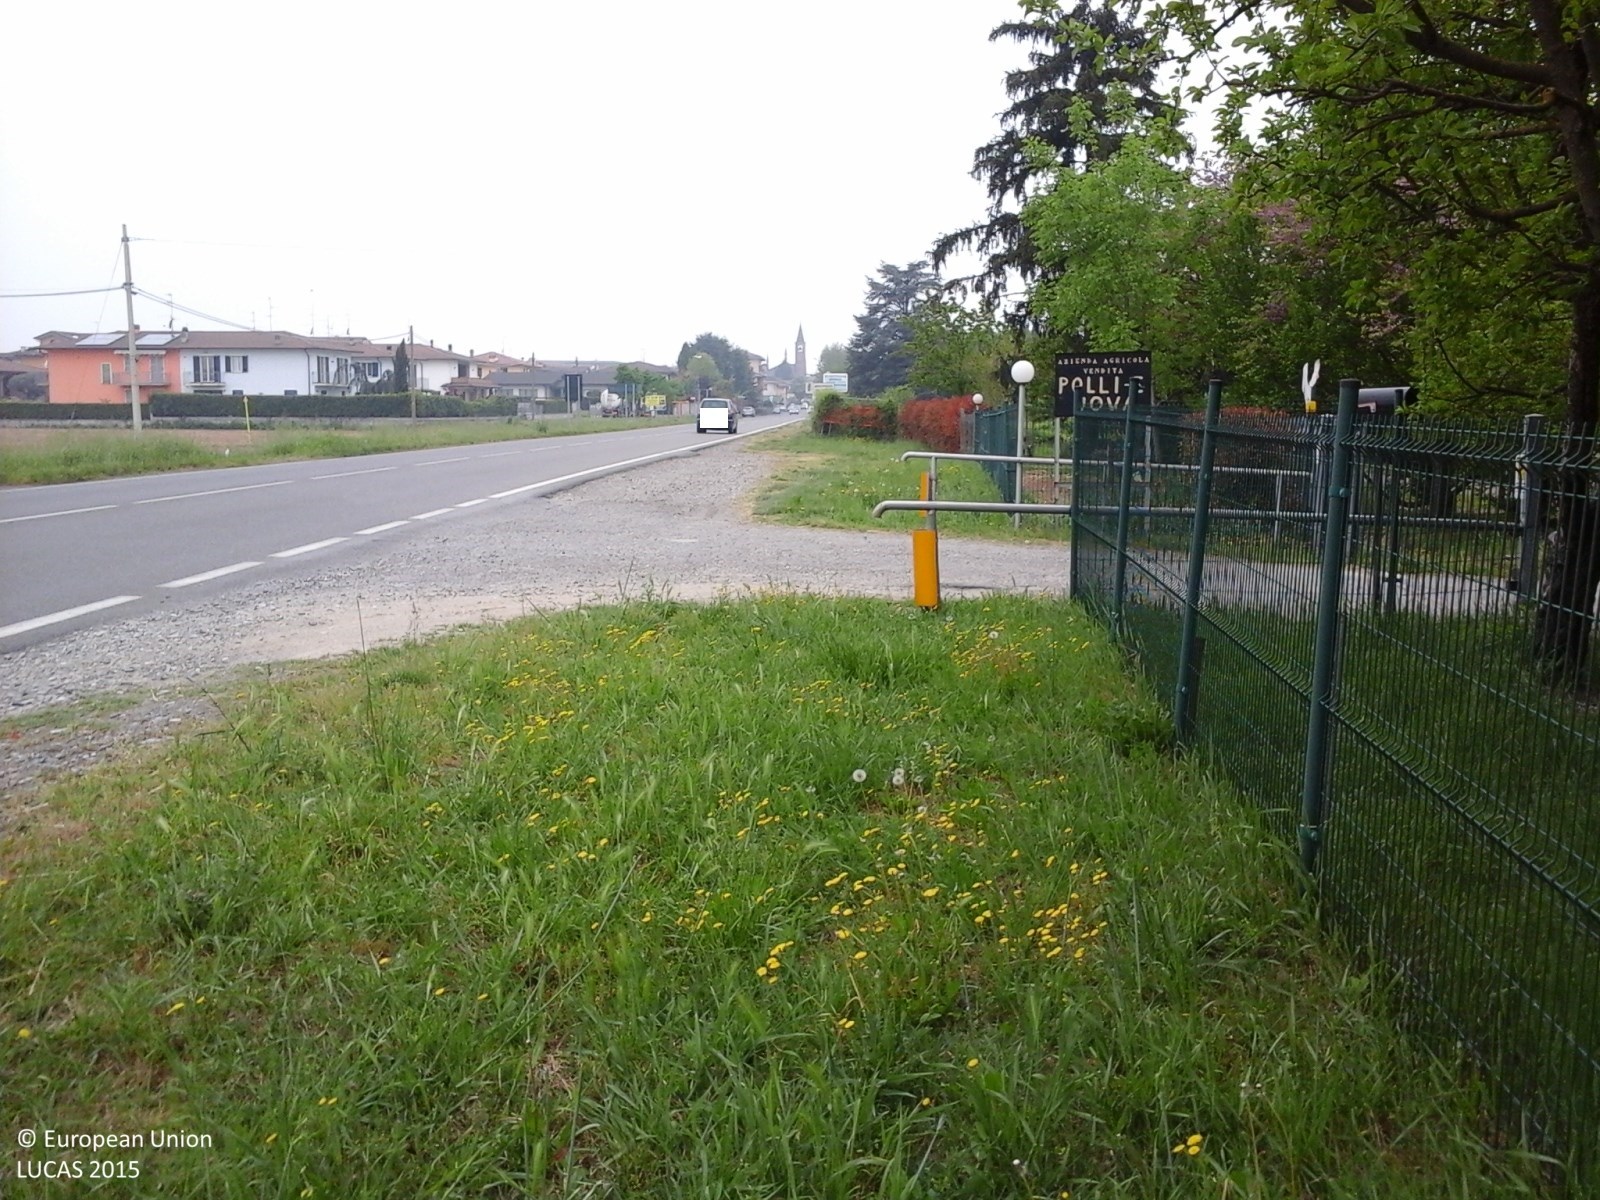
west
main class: Cropland
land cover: Other fresh vegetables
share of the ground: < 10 %
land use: Kitchen garden
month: April
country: IT
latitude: 45.0163
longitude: 9.4554
